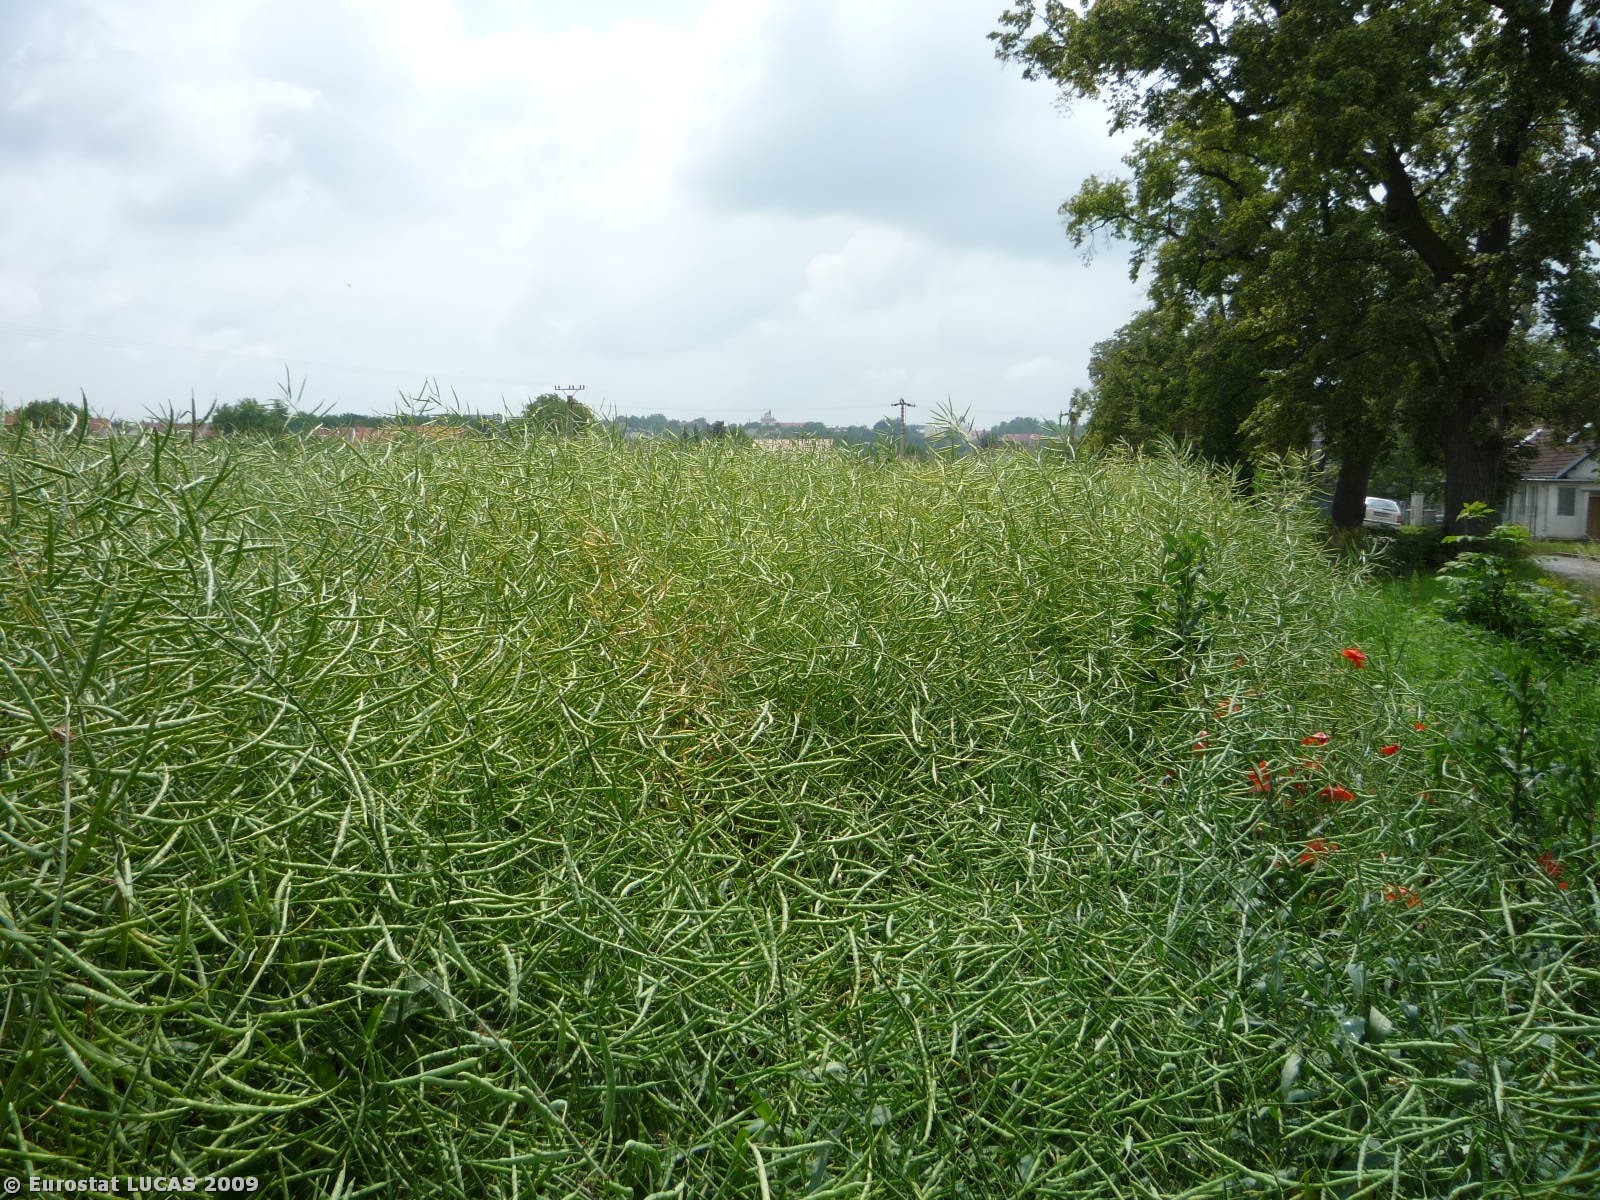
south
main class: Cropland
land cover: Rape and turnip rape
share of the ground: > 75 %
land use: Agriculture (excluding fallow land and kitchen gardens)
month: June
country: CZ
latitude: 49.9649
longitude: 15.0355
